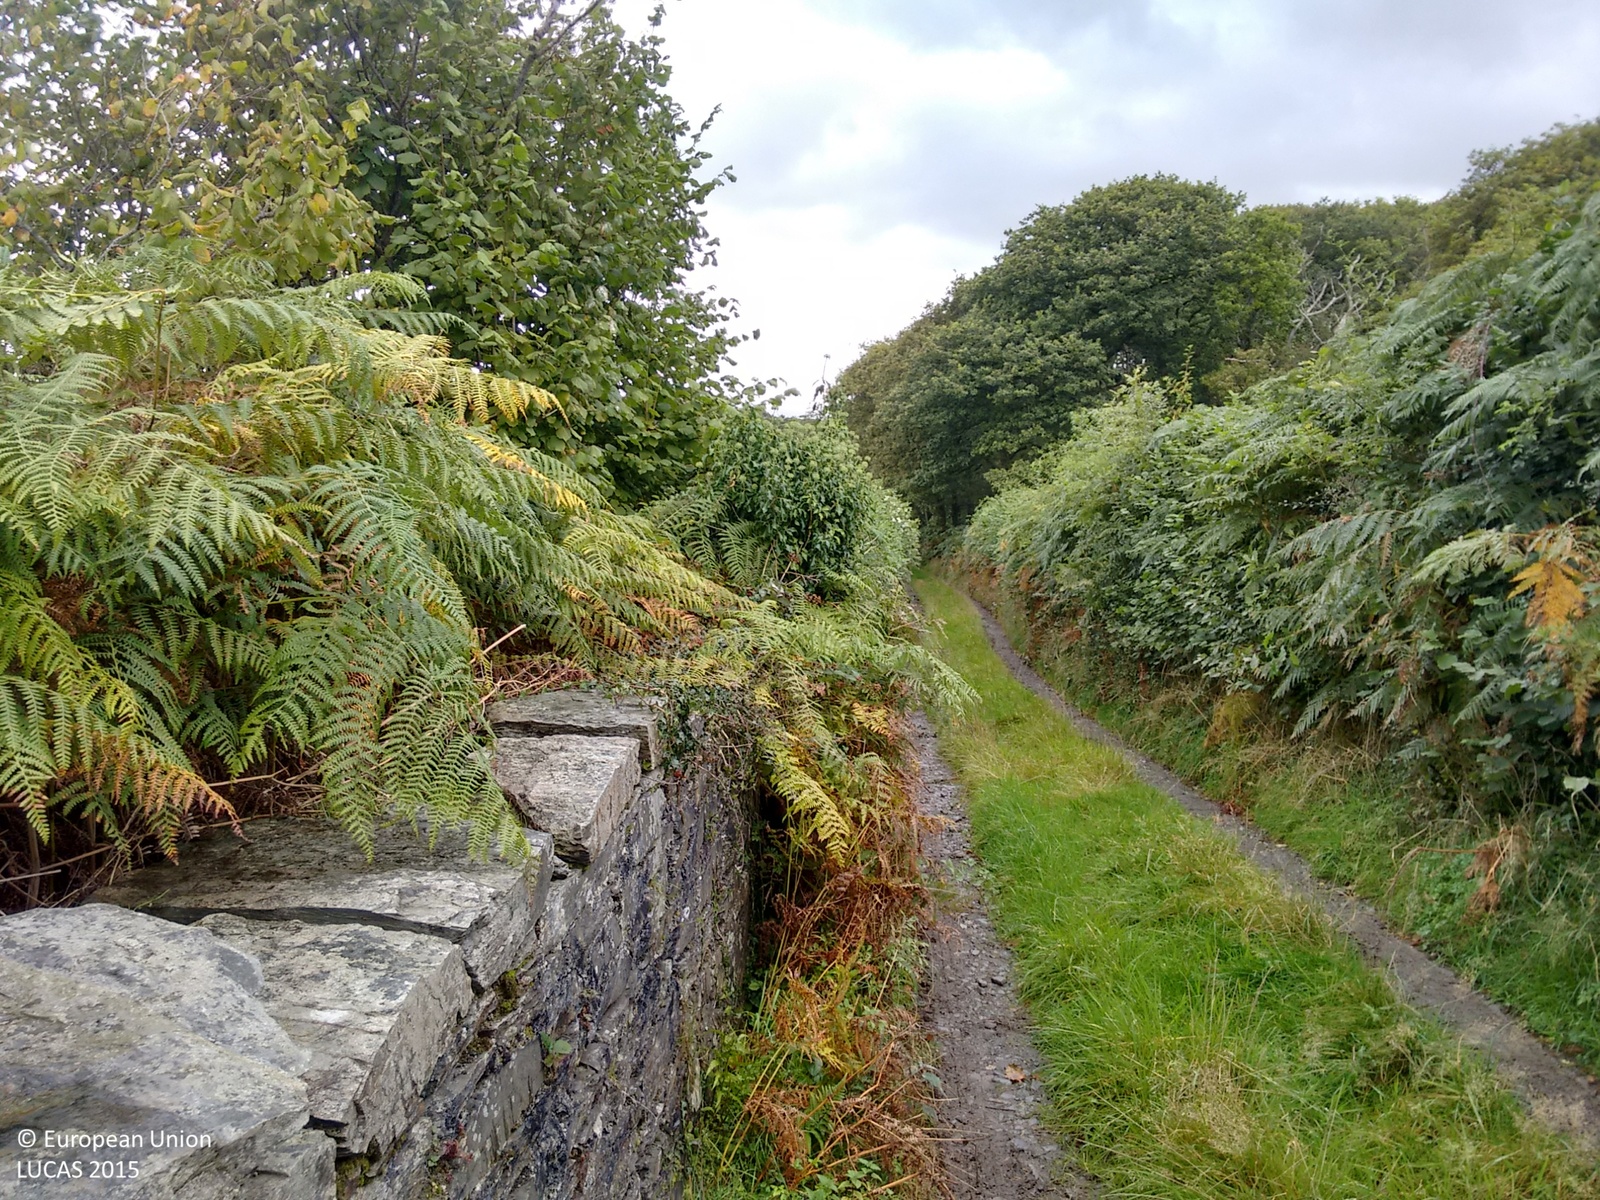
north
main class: Grassland
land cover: Grassland with sparse tree/shrub cover
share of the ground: > 75 %
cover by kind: herbaceous plants 95 %, broadleaved forest trees 5 %
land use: Agriculture (excluding fallow land and kitchen gardens)
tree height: > 5 m
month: October
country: GB
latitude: 52.5114
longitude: -3.9890
